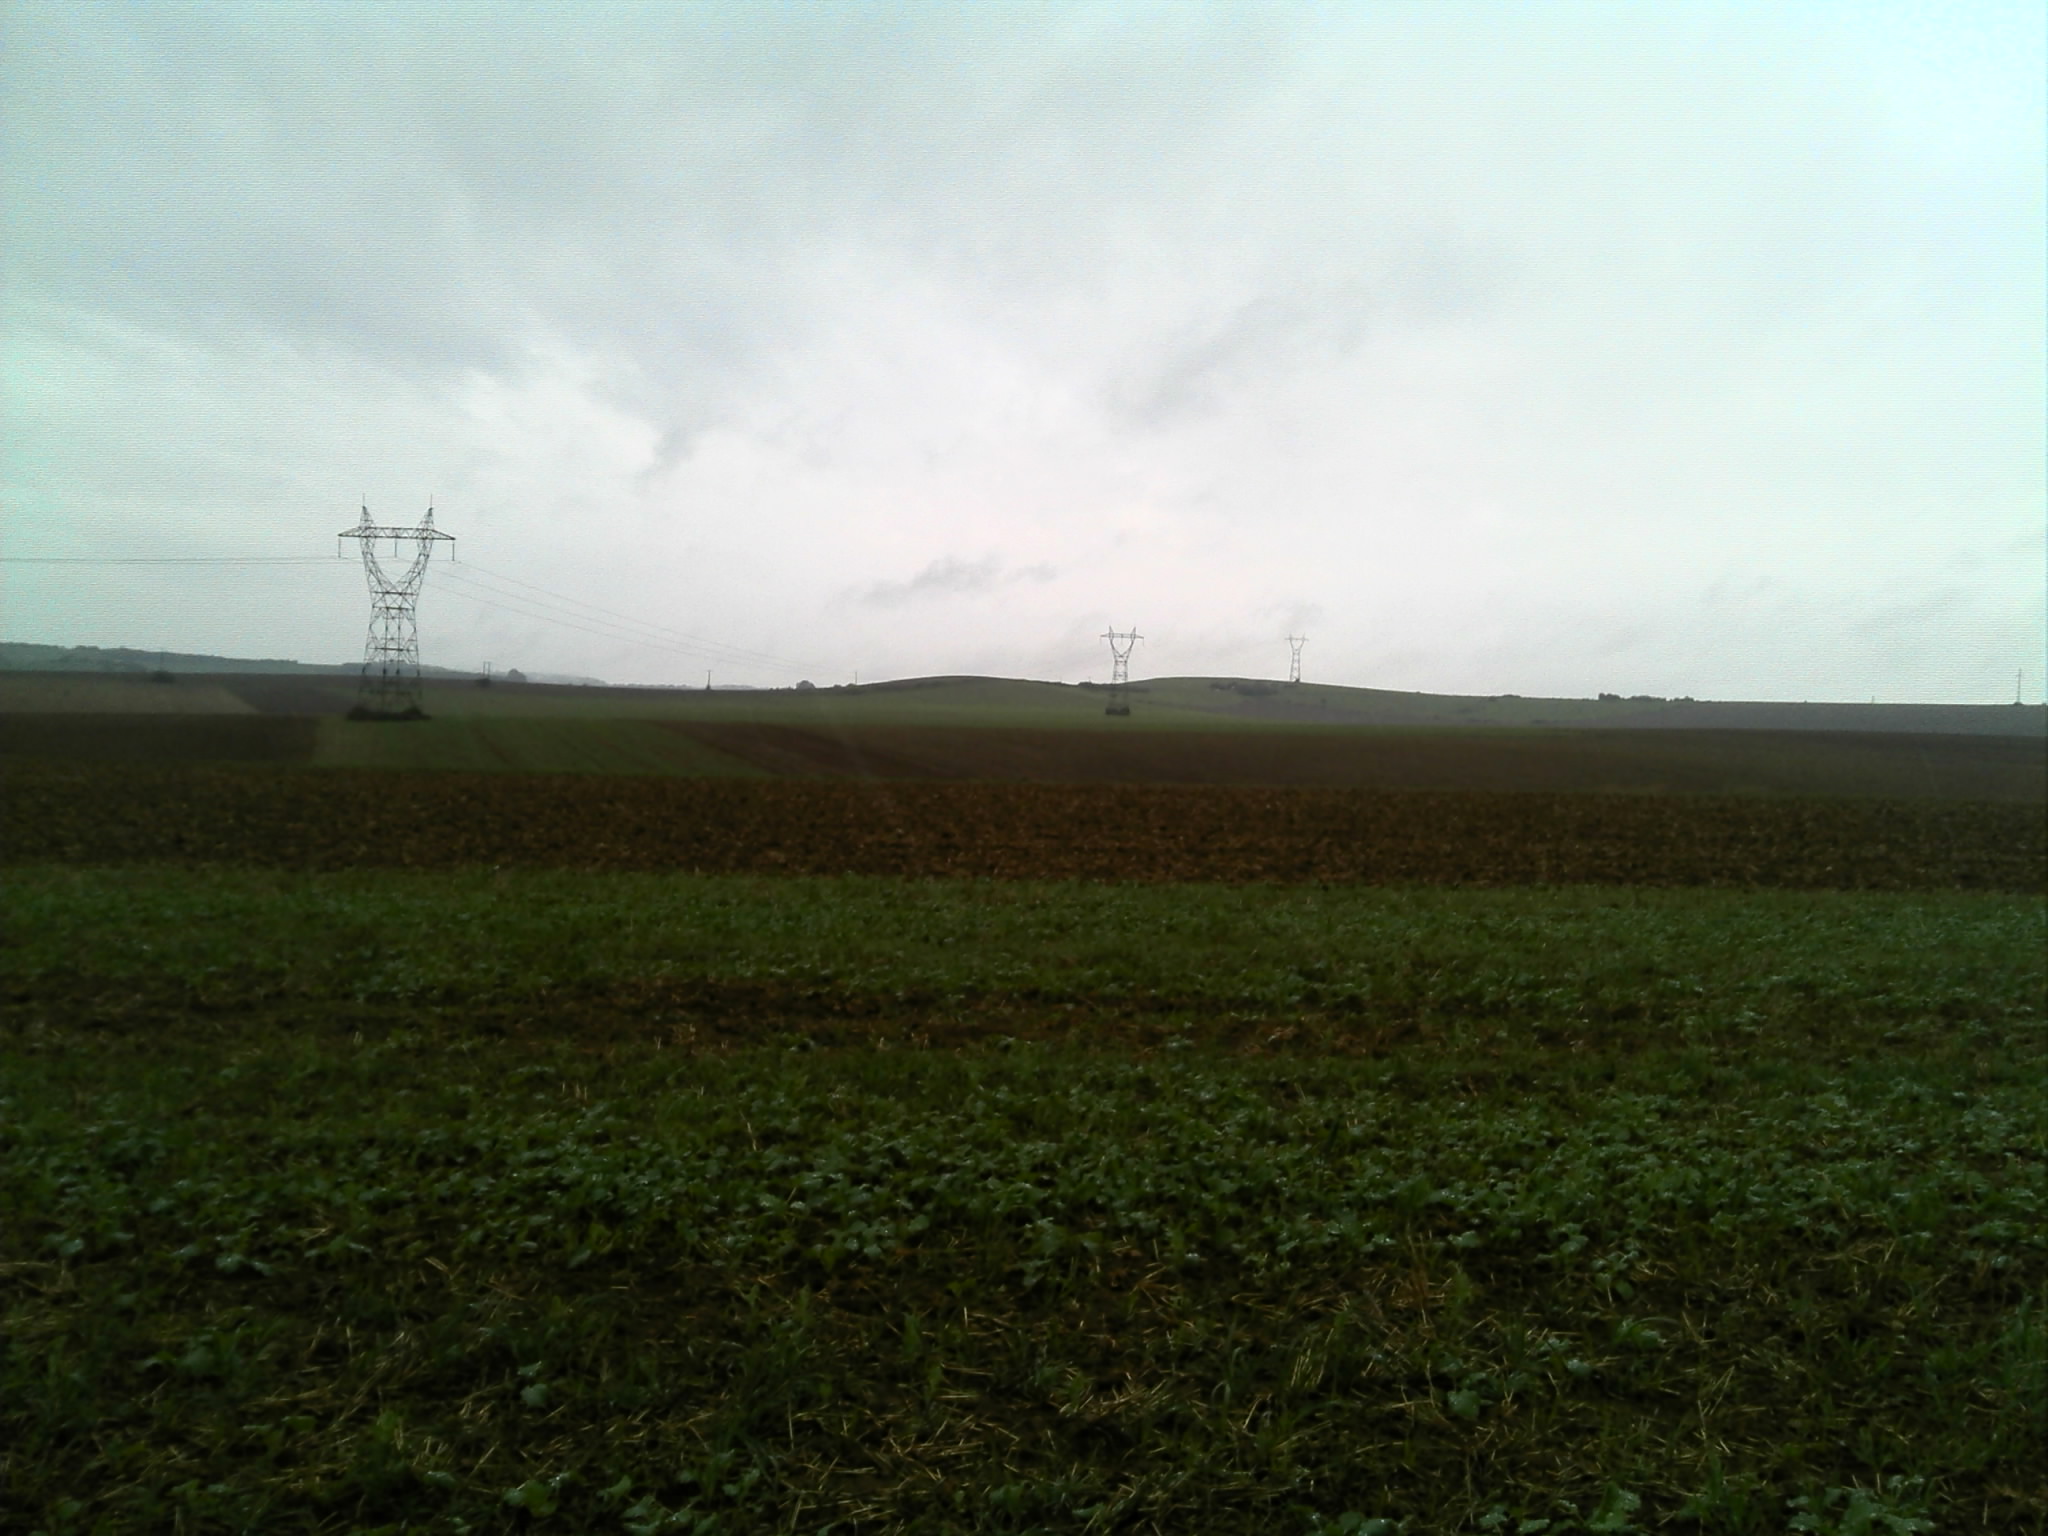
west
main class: Cropland
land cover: Rape and turnip rape
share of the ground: < 10 %
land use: Agriculture (excluding fallow land and kitchen gardens)
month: September
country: FR
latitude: 49.3367
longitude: 5.9119
